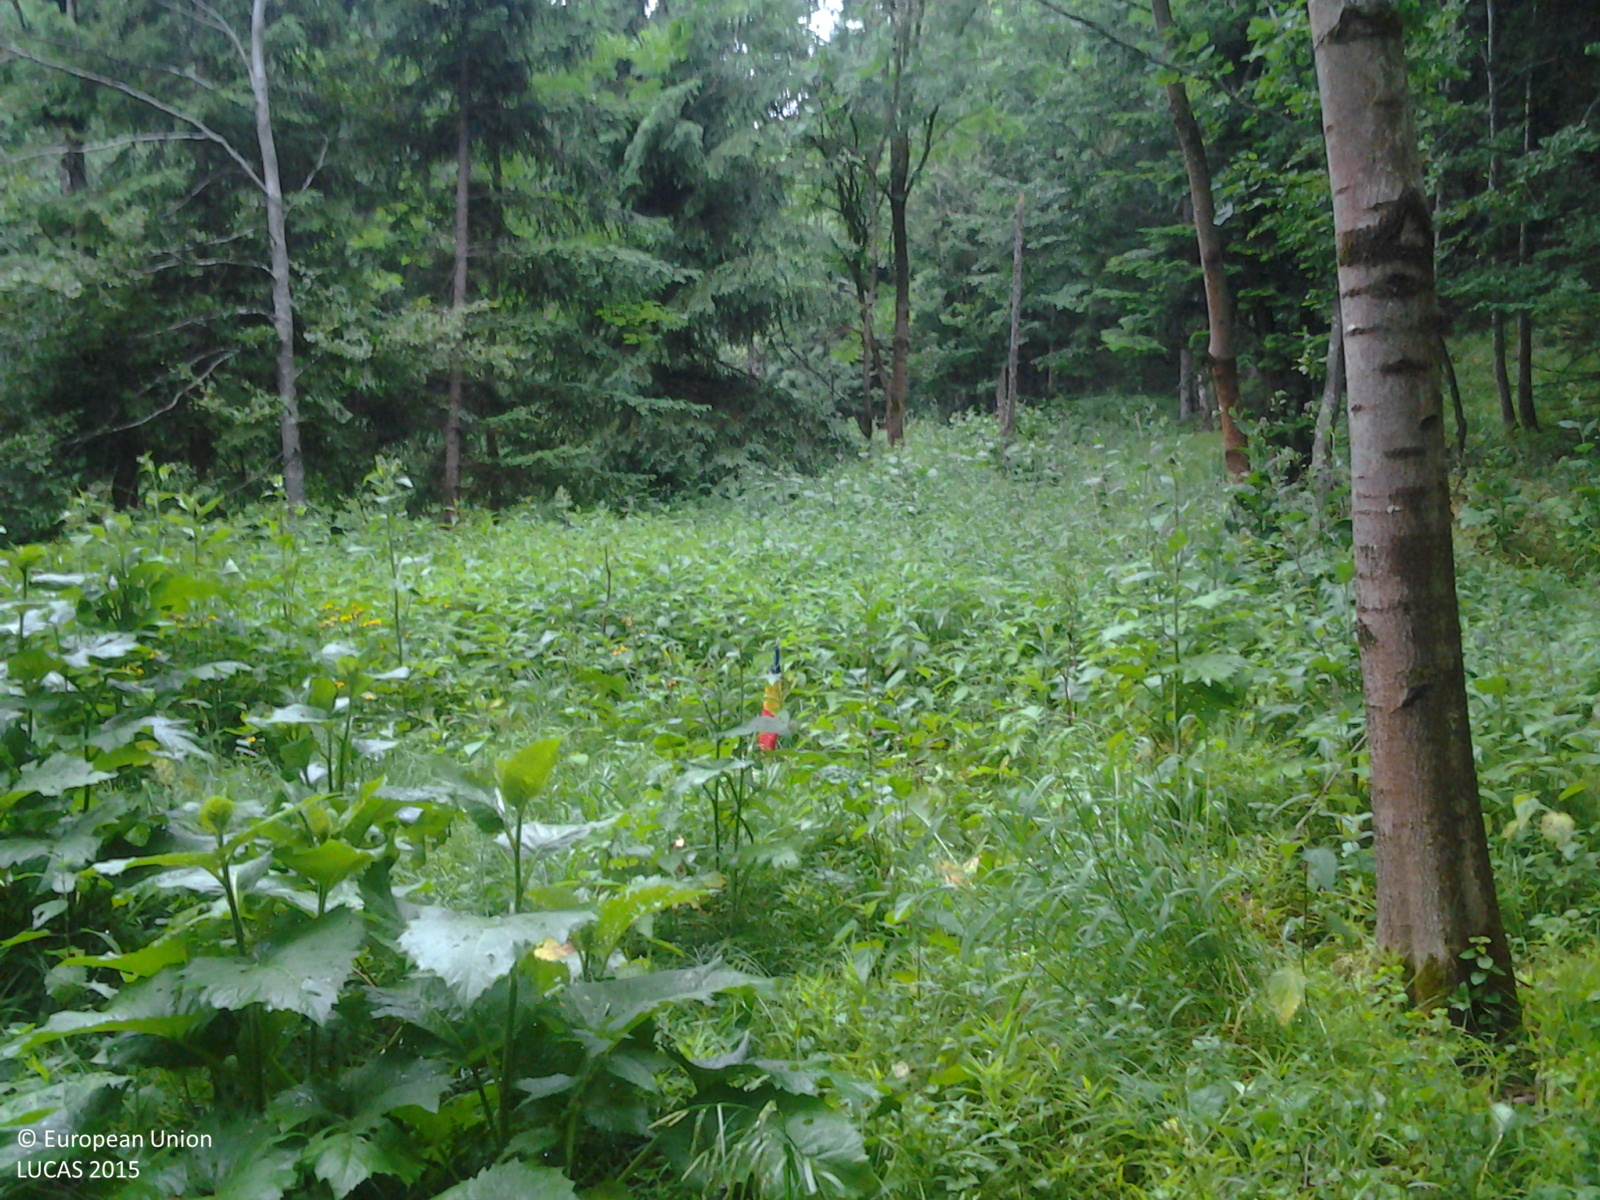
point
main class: Woodland
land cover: Other mixed woodland
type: alpine coniferous forest
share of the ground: > 75 %
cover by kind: coniferous forest trees 60 %, broadleaved forest trees 30 %, herbaceous plants 10 %
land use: Forestry
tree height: > 5 m
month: June
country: RO
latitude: 47.0391
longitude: 26.2808
